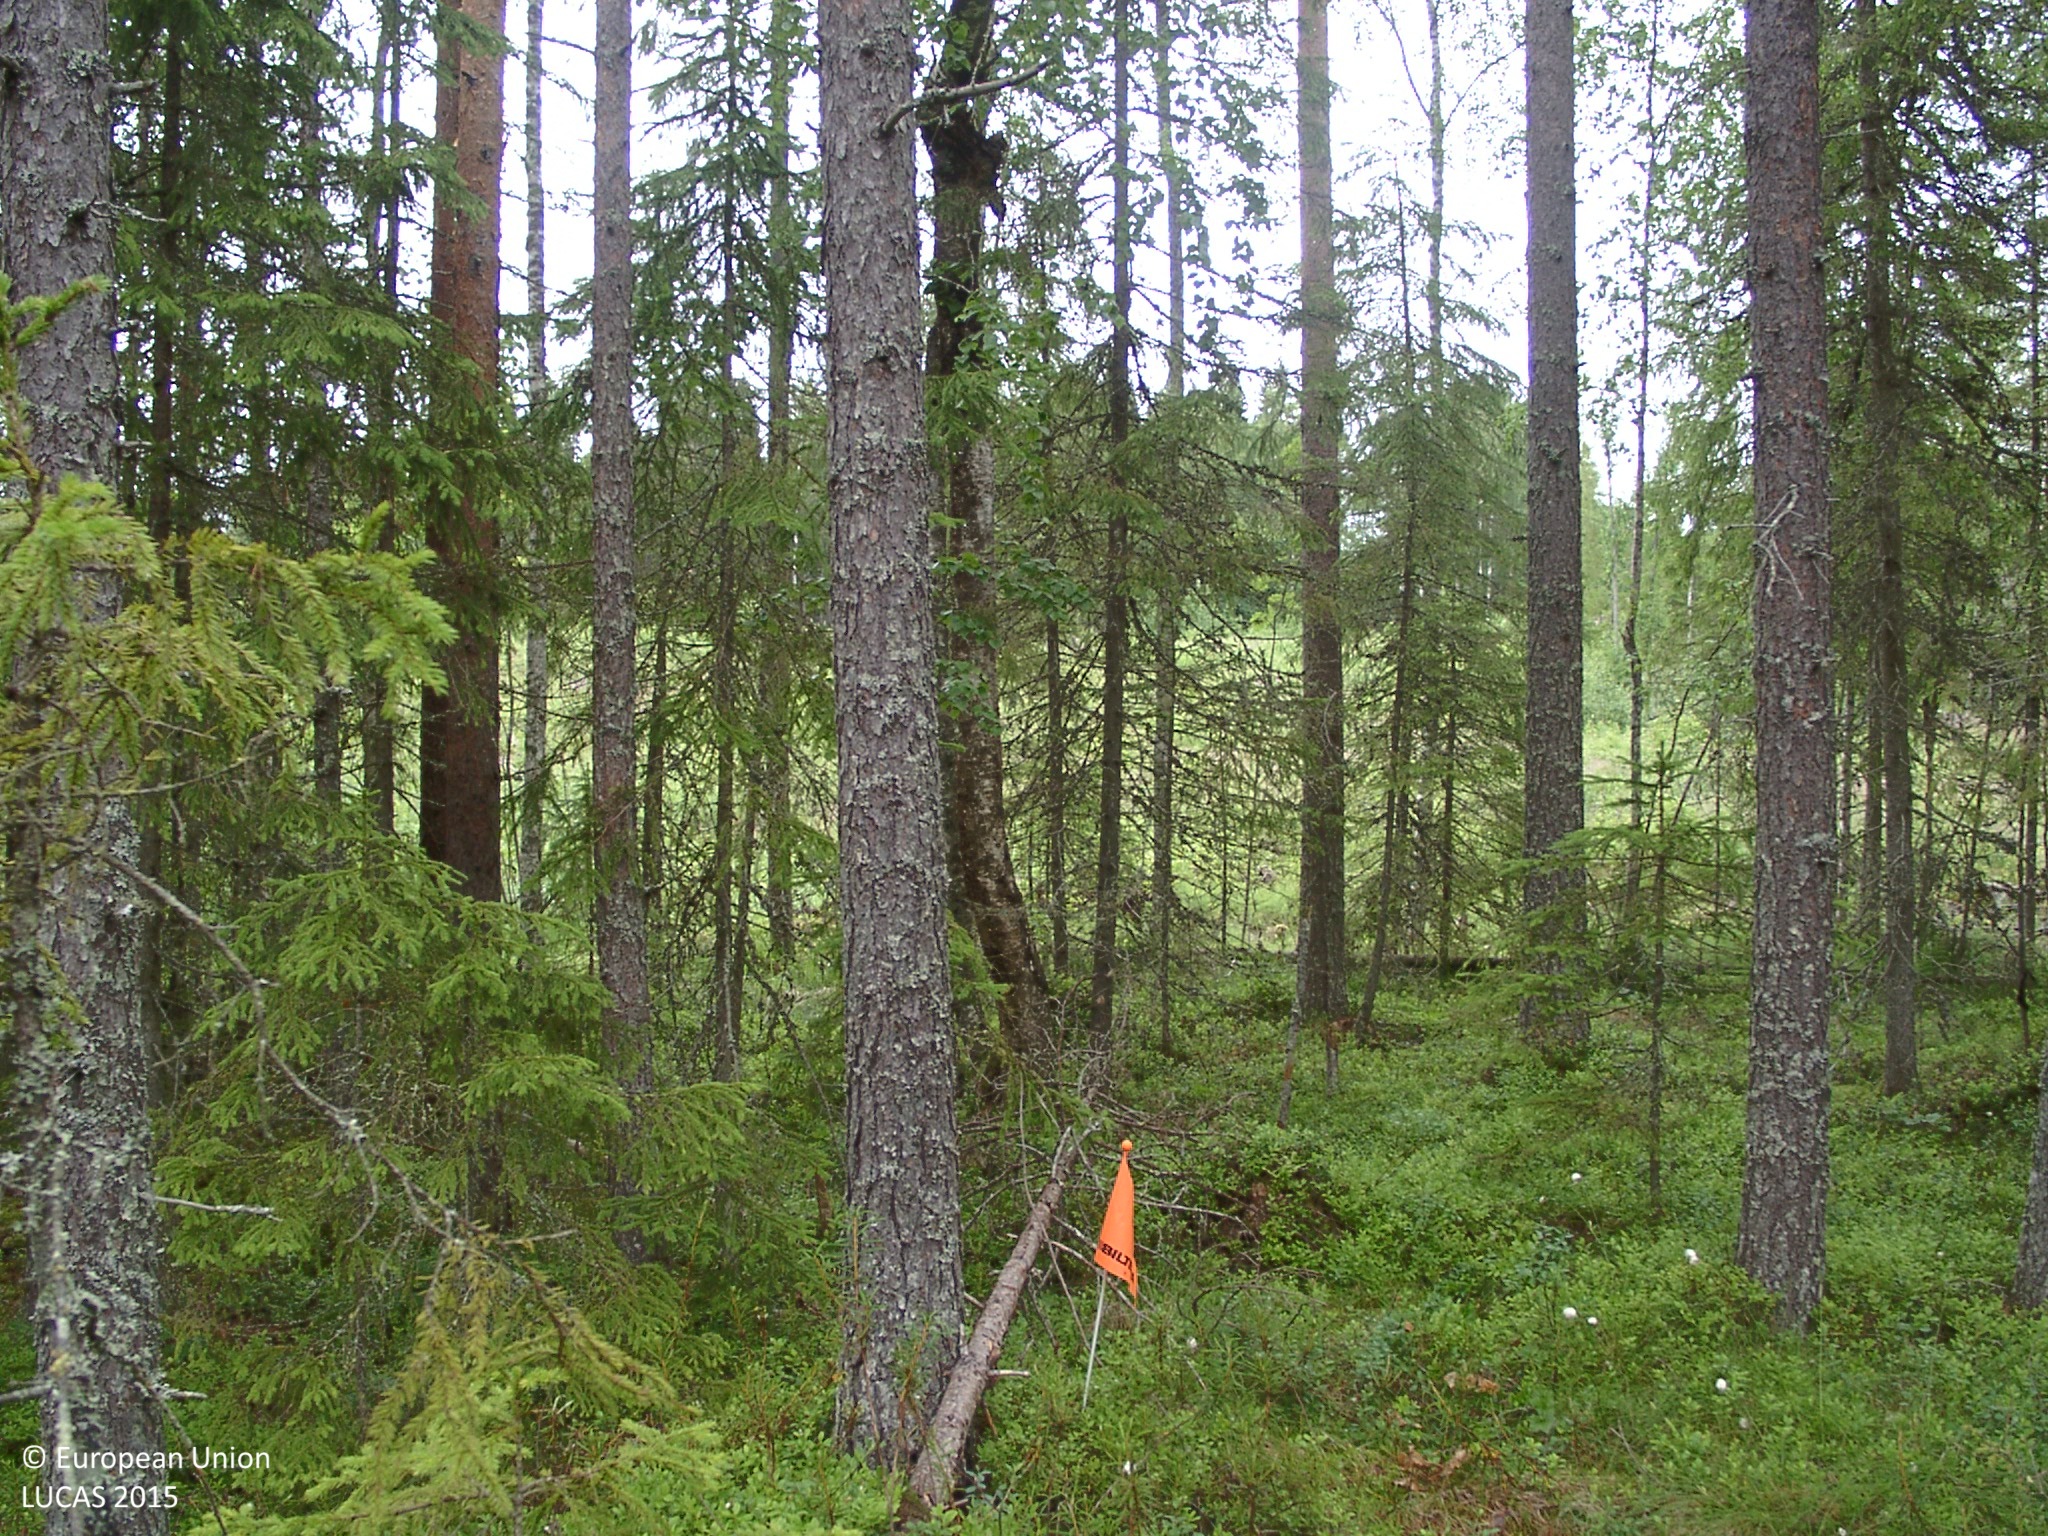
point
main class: Woodland
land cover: Other mixed woodland
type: boreal forest
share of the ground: > 75 %
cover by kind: coniferous forest trees 50 %, broadleaved forest trees 25 %, shrubs 10 %, lichens and mosses 10 %, herbaceous plants 5 %
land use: Semi-natural and natural areas not in use
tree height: > 5 m
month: July
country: FI
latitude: 62.1484
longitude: 25.3658
